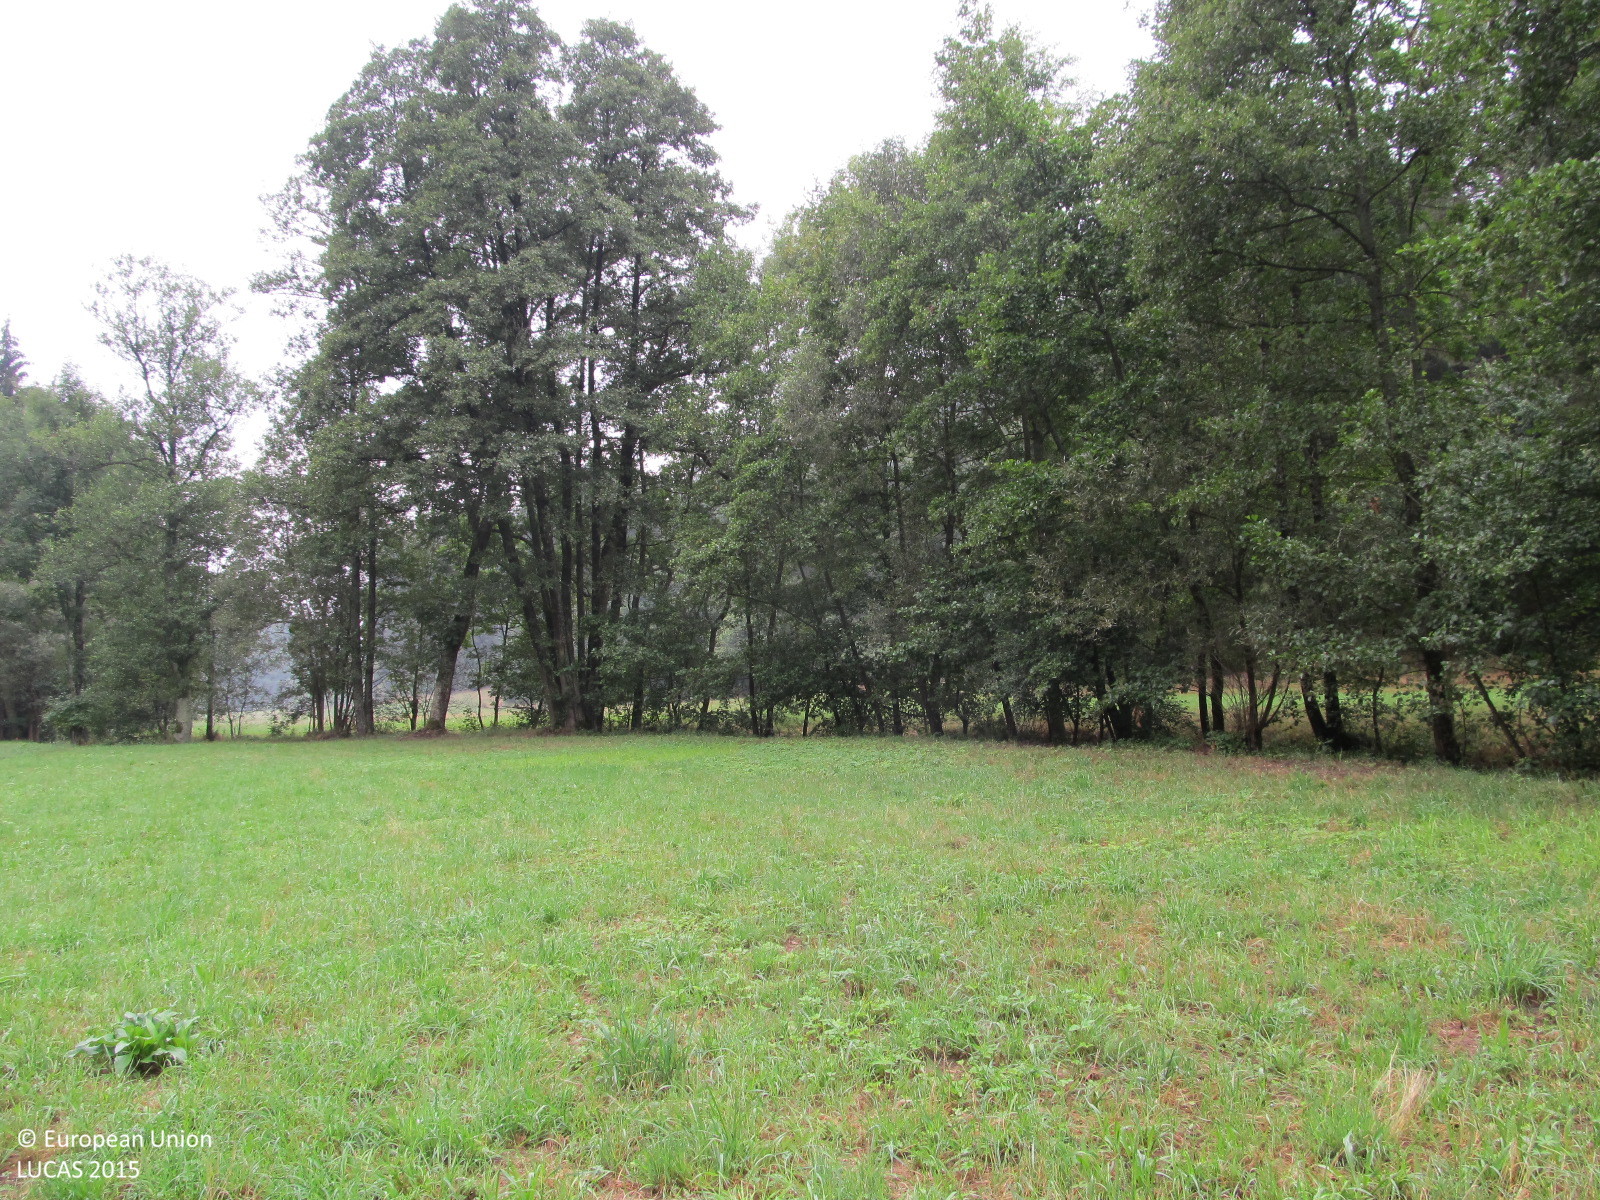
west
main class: Grassland
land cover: Grassland without tree/shrub cover
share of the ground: > 75 %
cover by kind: herbaceous plants 100 %
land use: Agriculture (excluding fallow land and kitchen gardens)
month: August
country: AT
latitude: 48.8094
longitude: 15.4634
